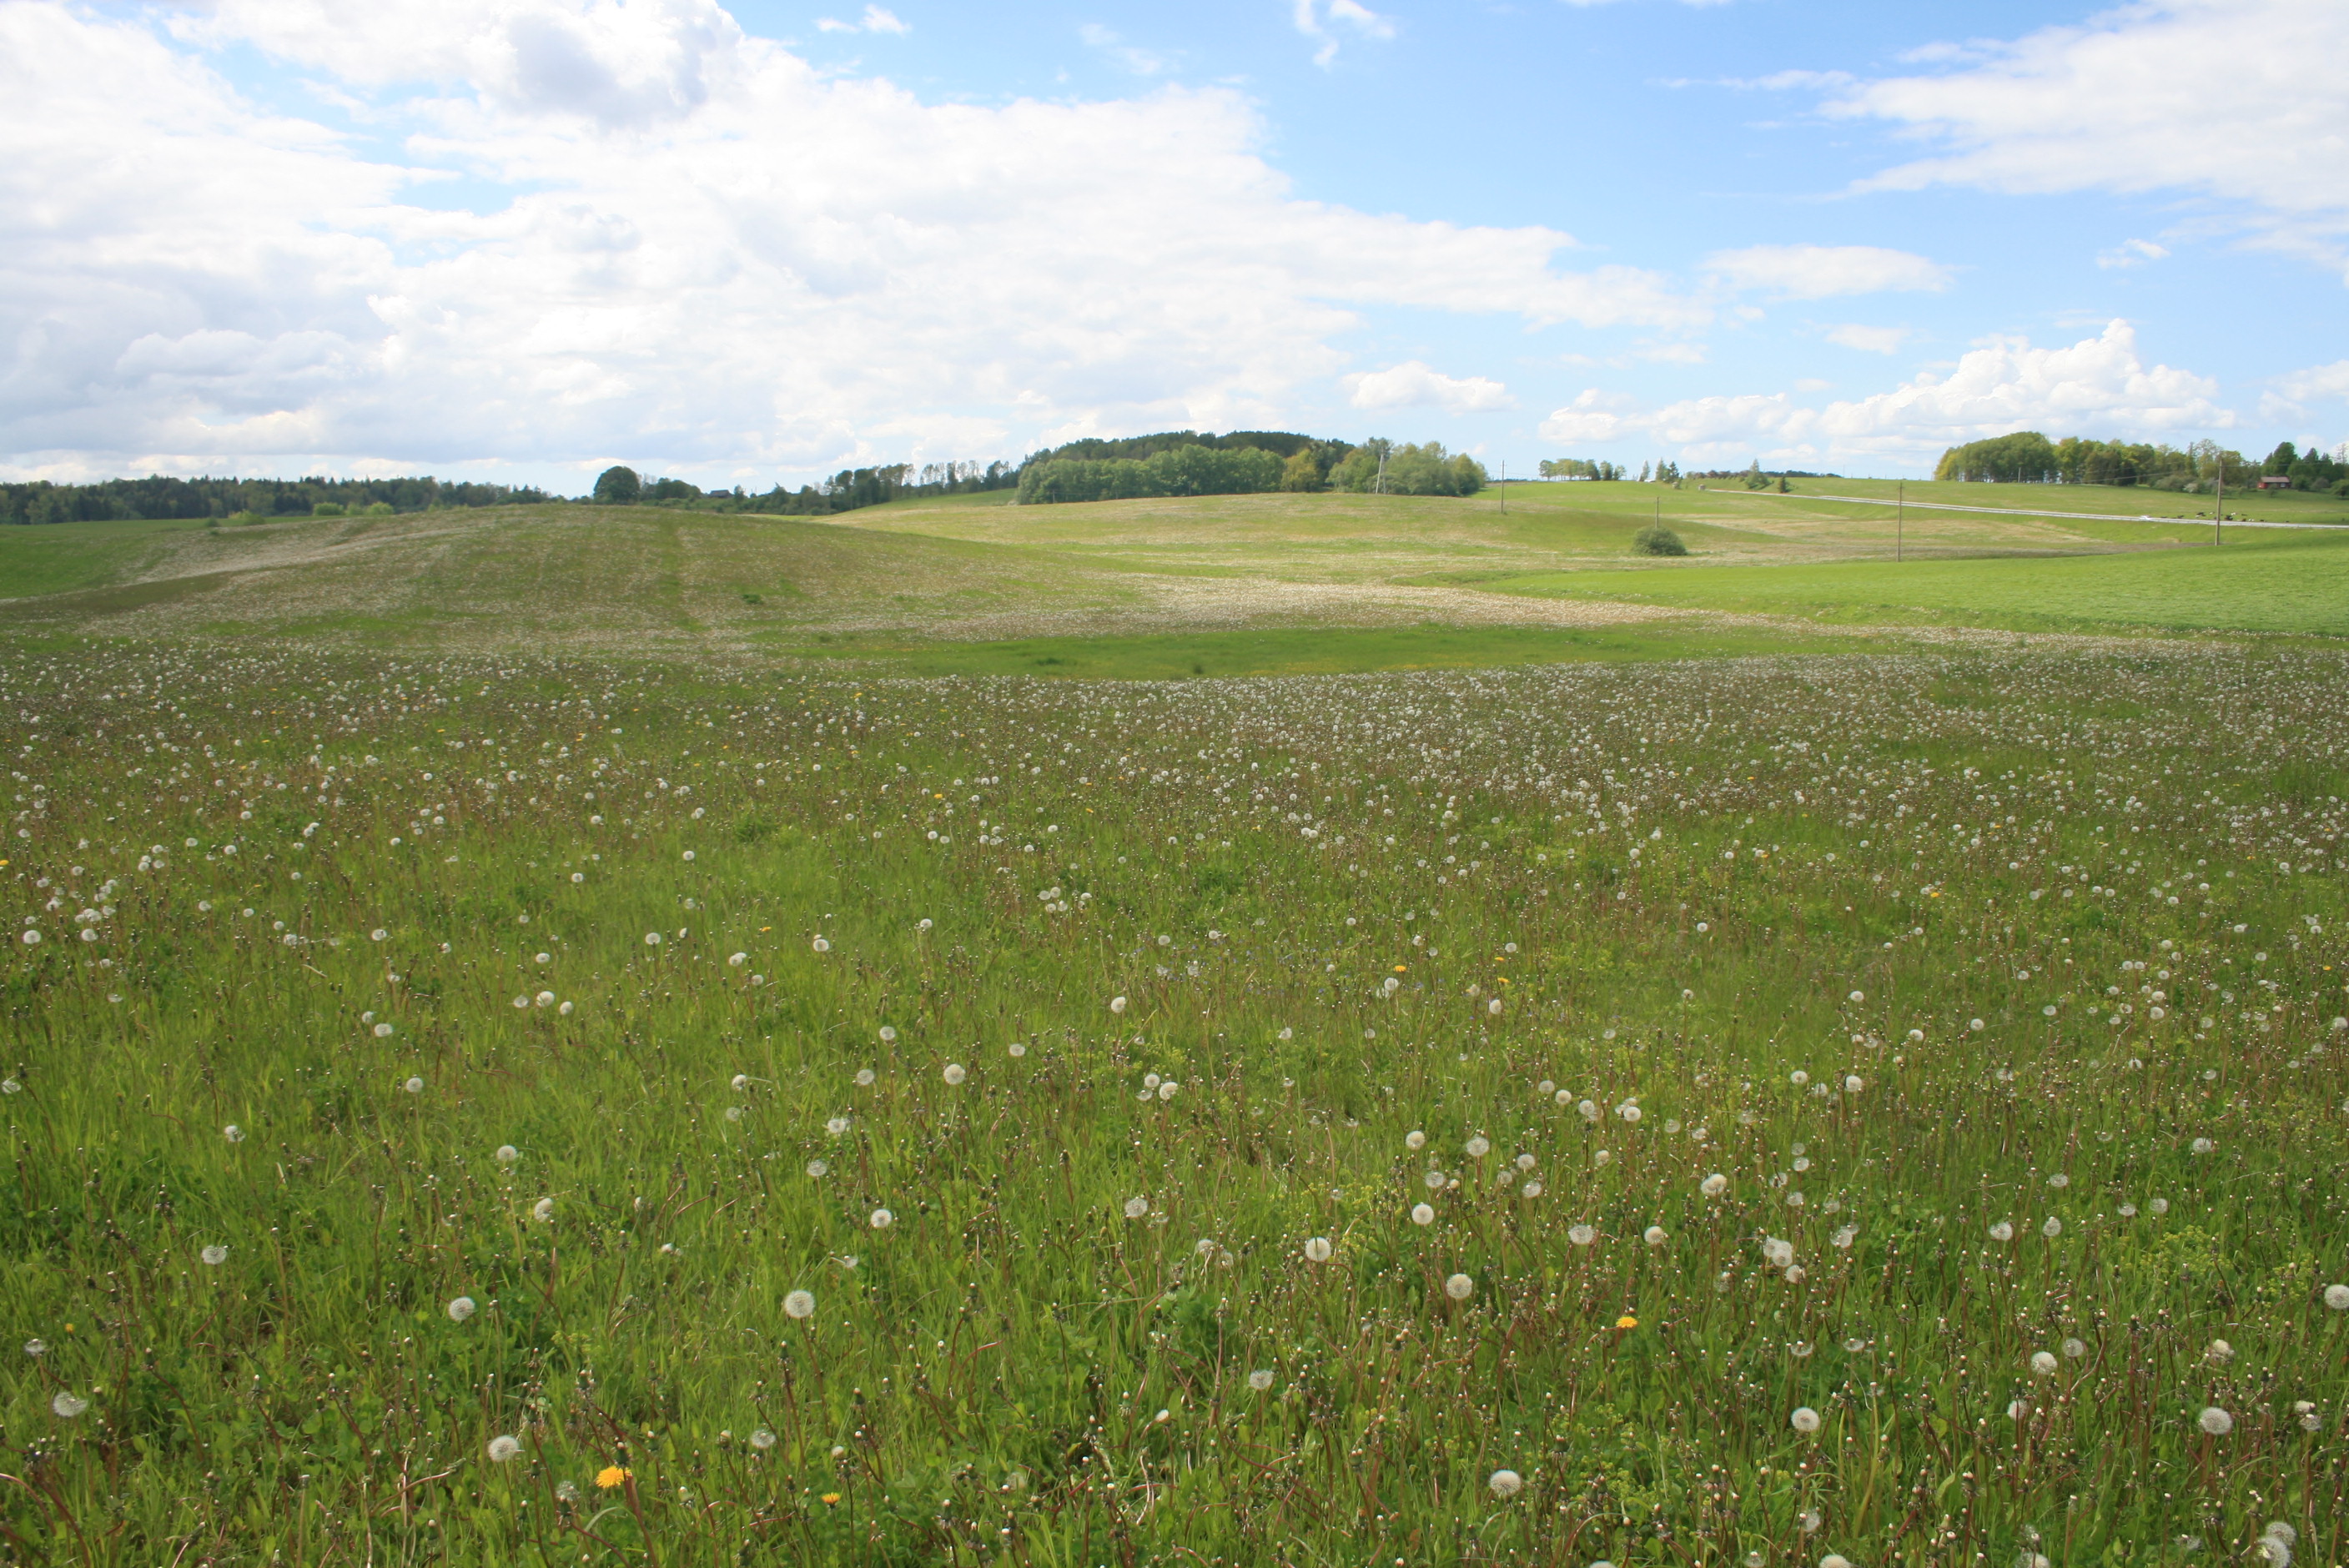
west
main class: Grassland
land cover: Grassland without tree/shrub cover
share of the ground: > 75 %
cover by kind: herbaceous plants 100 %
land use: Agriculture (excluding fallow land and kitchen gardens)
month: May
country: LT
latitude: 56.0011
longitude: 22.2255
